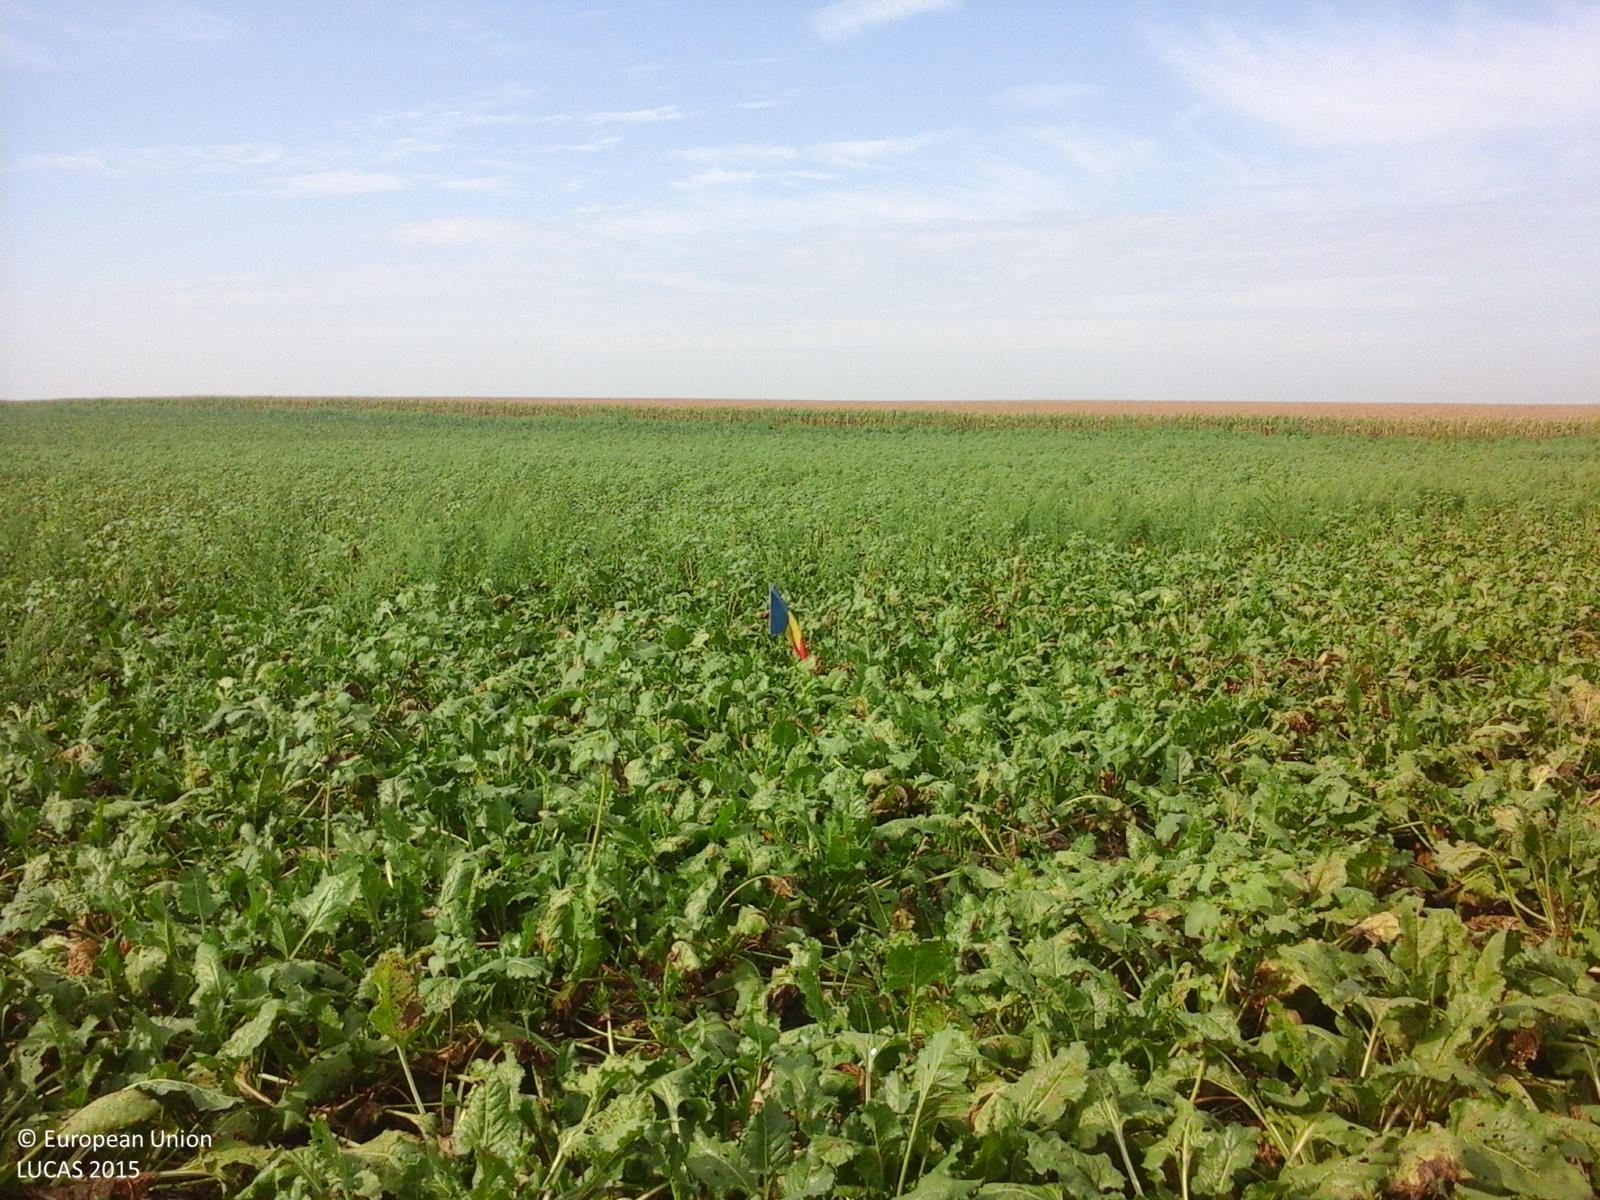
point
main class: Cropland
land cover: Sugar beet
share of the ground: > 75 %
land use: Agriculture (excluding fallow land and kitchen gardens)
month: August
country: RO
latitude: 46.1769
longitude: 20.8712
